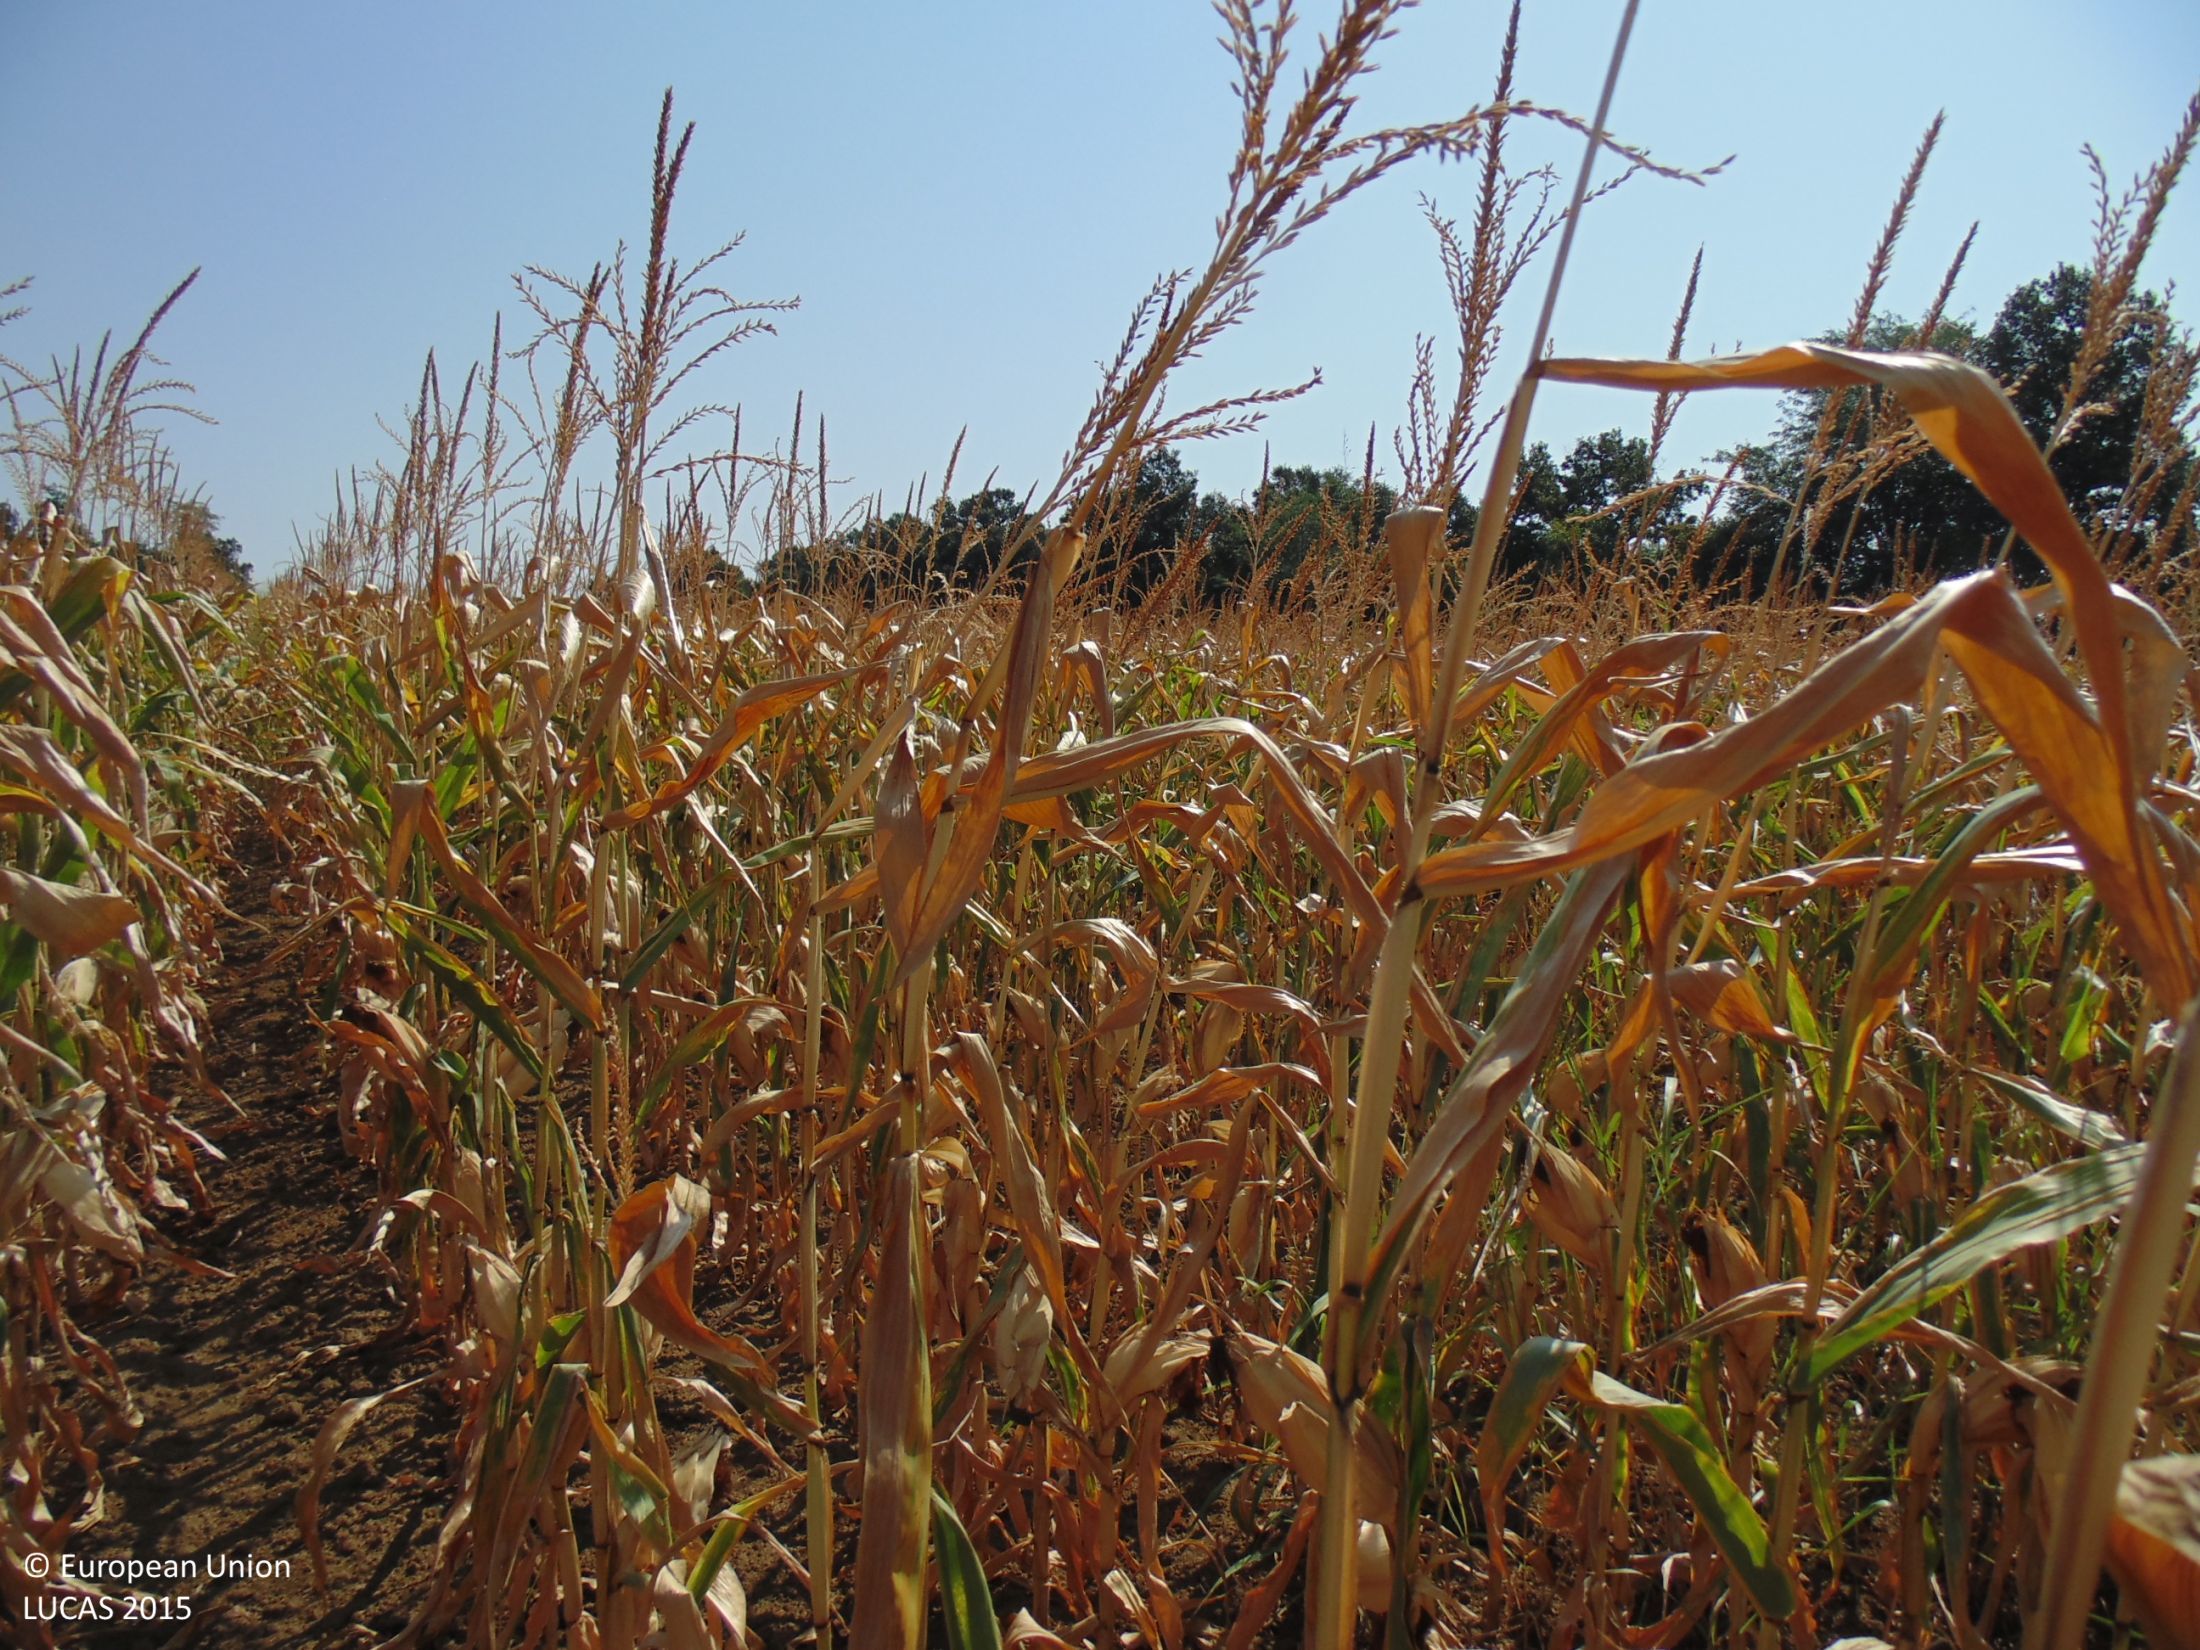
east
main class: Cropland
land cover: Maize
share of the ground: > 75 %
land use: Agriculture (excluding fallow land and kitchen gardens)
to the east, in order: Maize; Grass margins; Ditches and canals; Grass margins; Paved roads, cycling and walking lanes; Grass margins; Ditches and canals; Broadleaved woodland; Grass margins; Maize
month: August
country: BG
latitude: 44.0036
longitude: 27.5361
